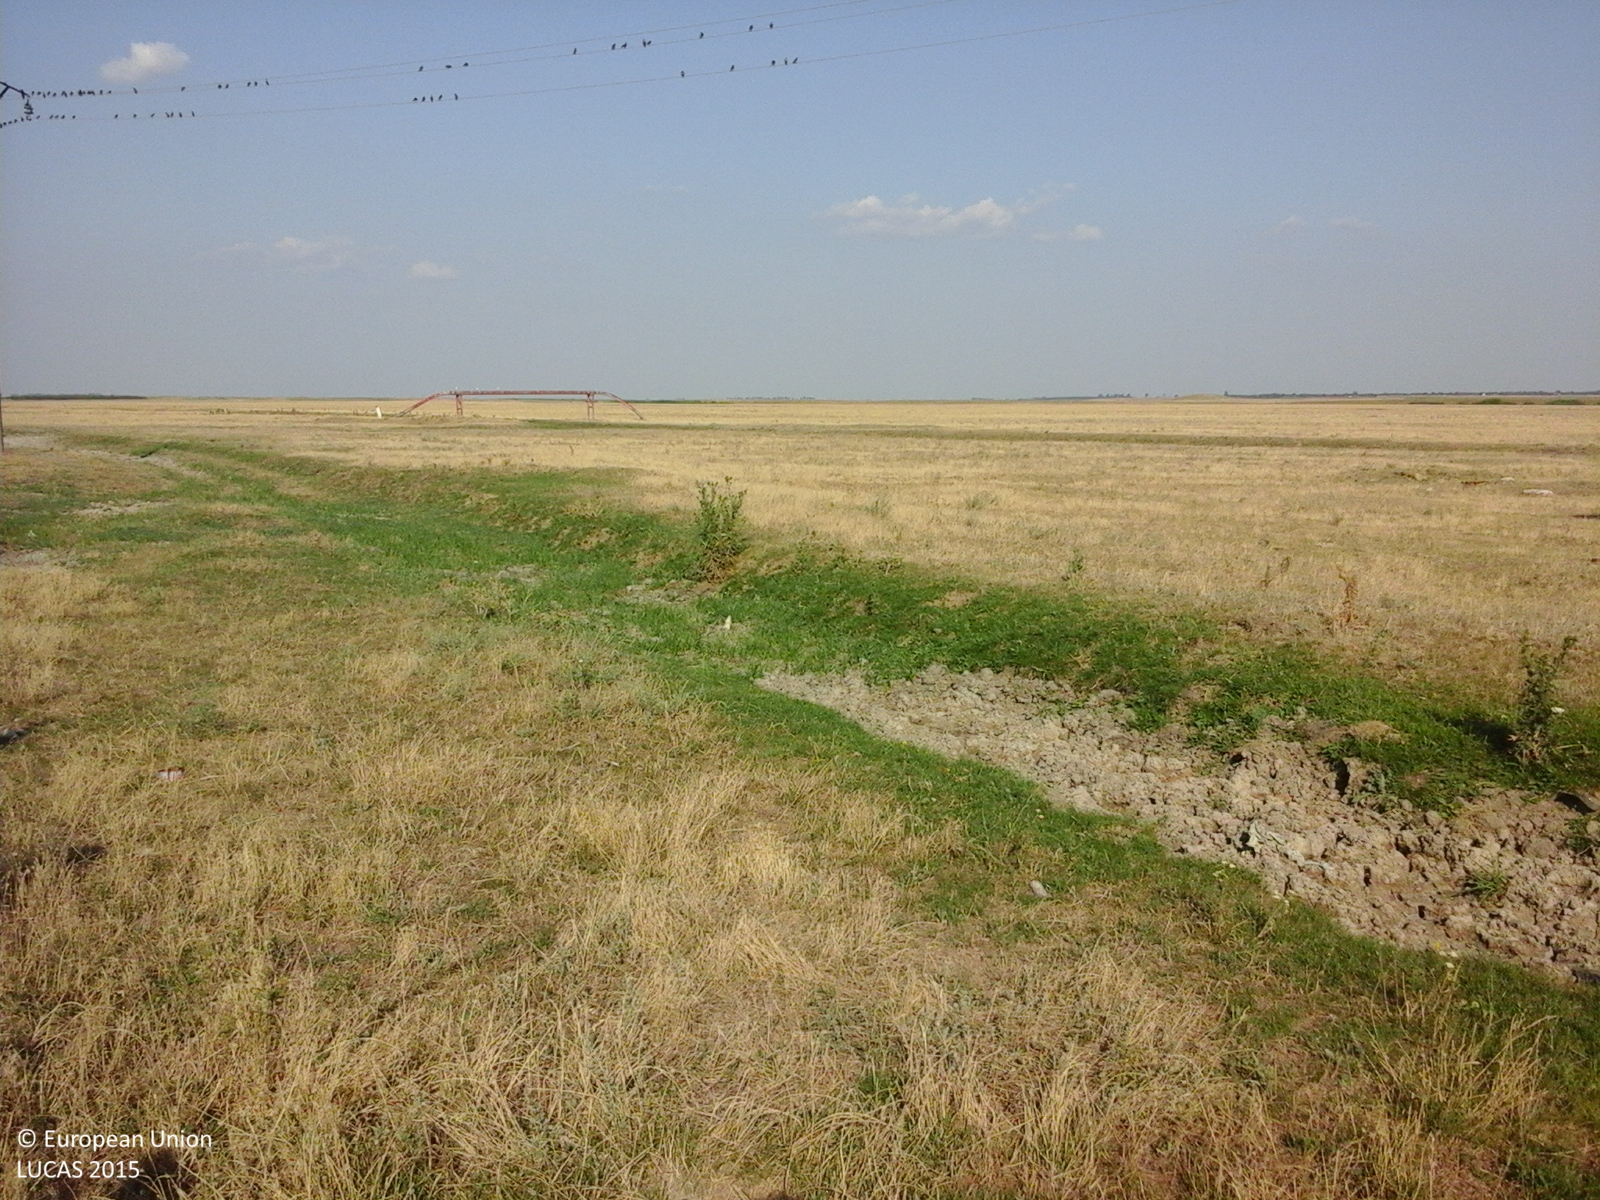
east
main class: Grassland
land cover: Spontaneously vegetated surfaces
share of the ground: > 75 %
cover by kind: herbaceous plants 100 %
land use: Agriculture (excluding fallow land and kitchen gardens)
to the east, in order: Spontaneously vegetated surfaces; Fences; Grassland without tree/shrub cover; Electric lines; Grassland without tree/shrub cover; Ditches and canals; Grassland without tree/shrub cover; Ditches and canals; Grassland without tree/shrub cover; Ditches and canals; Grassland without tree/shrub cover; Other root crops; Grassland without tree/shrub cover; Ditches and canals; Grassland without tree/shrub cover
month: July
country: RO
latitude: 44.9702
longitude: 27.3756
